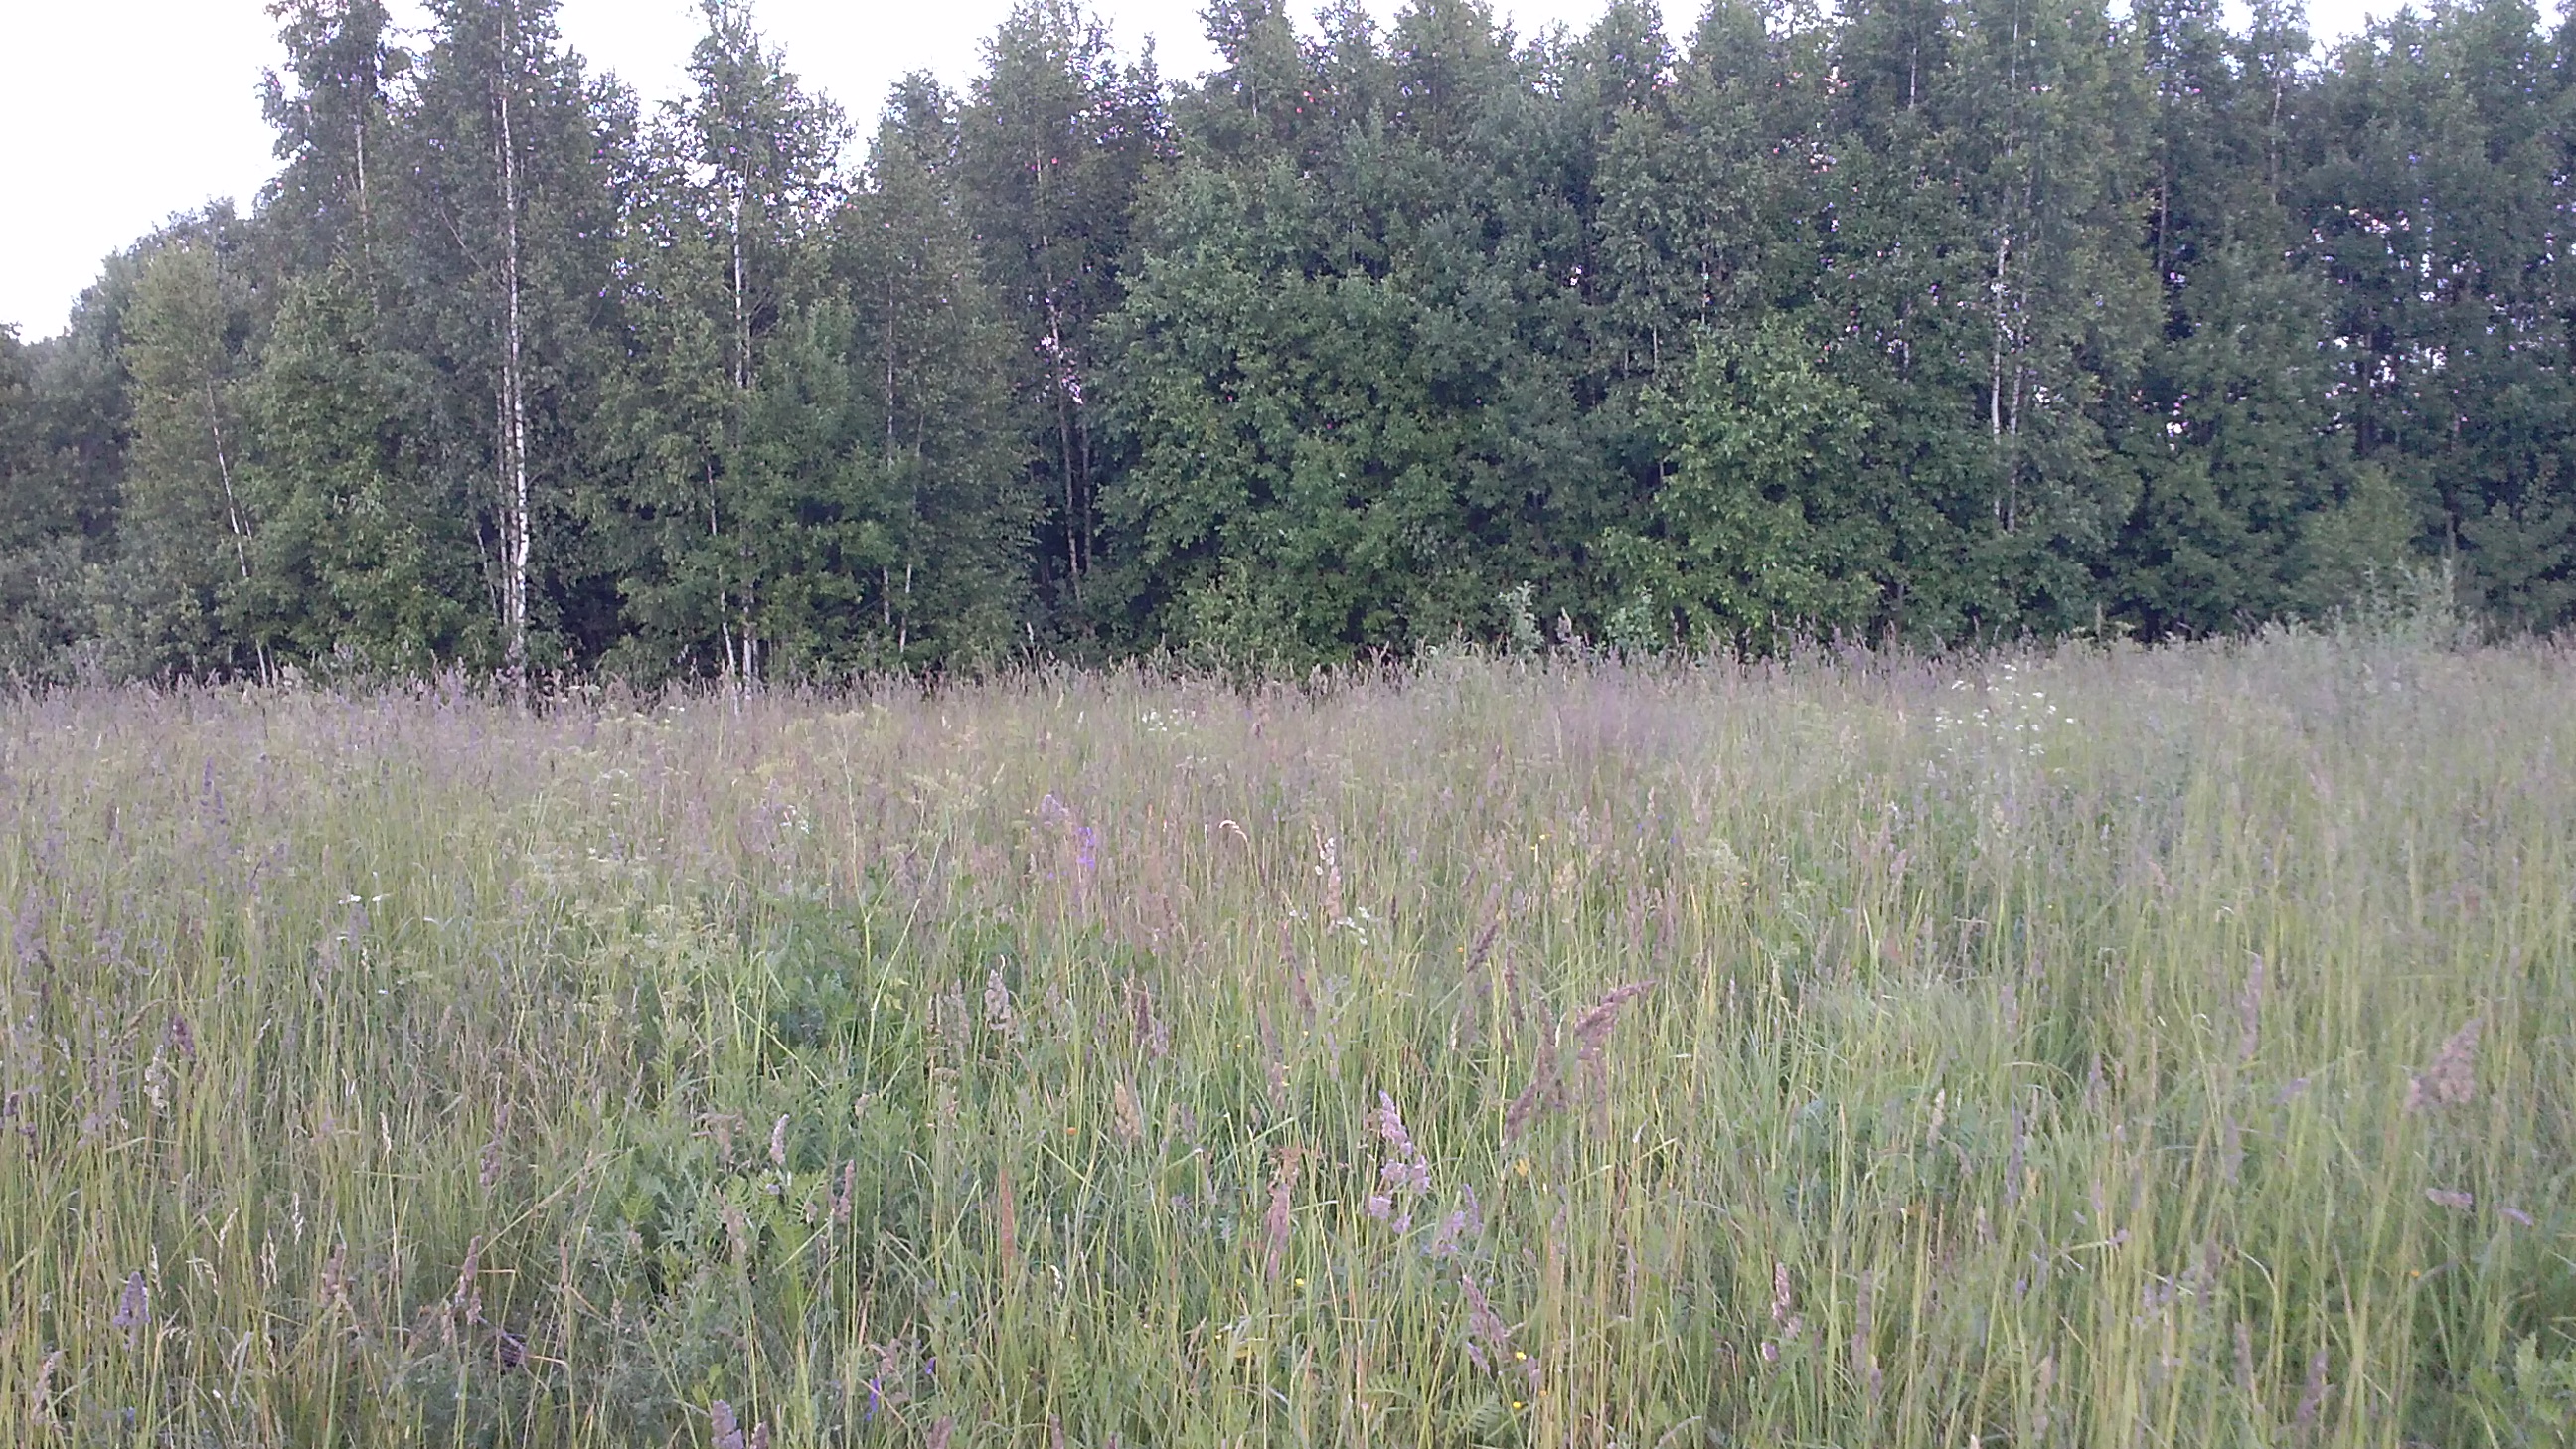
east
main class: Grassland
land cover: Grassland without tree/shrub cover
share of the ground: > 75 %
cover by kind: herbaceous plants 100 %
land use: Agriculture (excluding fallow land and kitchen gardens)
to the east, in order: Grassland without tree/shrub cover; Broadleaved woodland; Grassland without tree/shrub cover; Broadleaved woodland; Grassland without tree/shrub cover
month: June
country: LV
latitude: 56.5647
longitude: 27.9820
